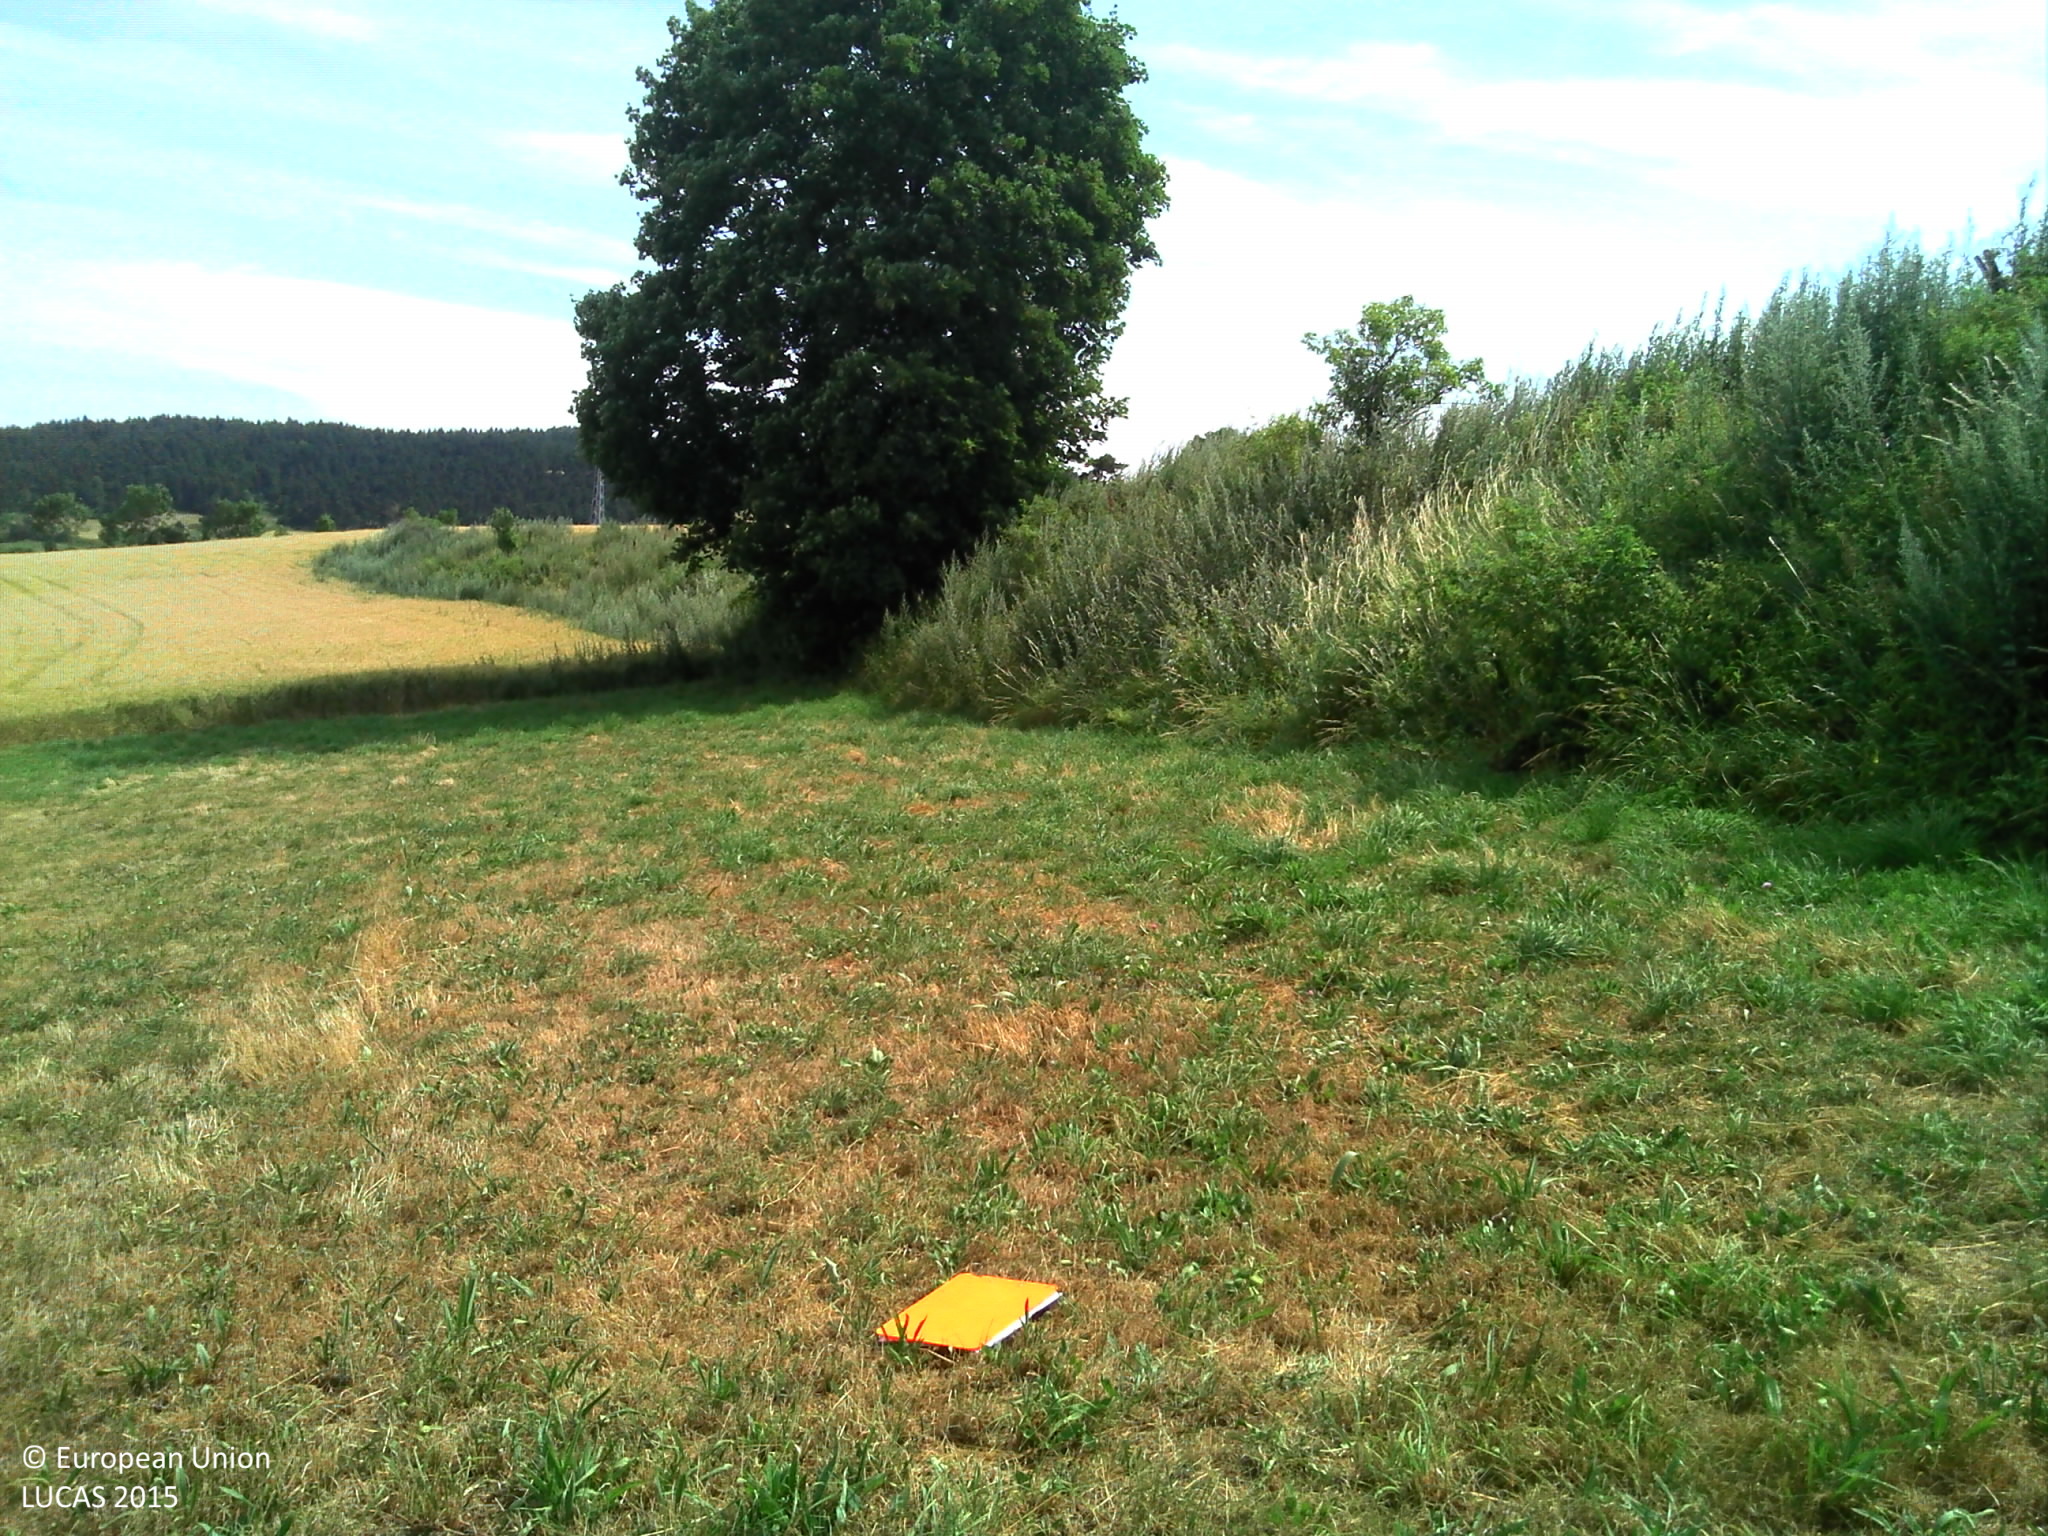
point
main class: Grassland
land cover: Grassland without tree/shrub cover
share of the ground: > 75 %
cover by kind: herbaceous plants 100 %
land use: Agriculture (excluding fallow land and kitchen gardens)
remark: Harvested field
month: July
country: FR
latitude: 44.8397
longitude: 3.8946
